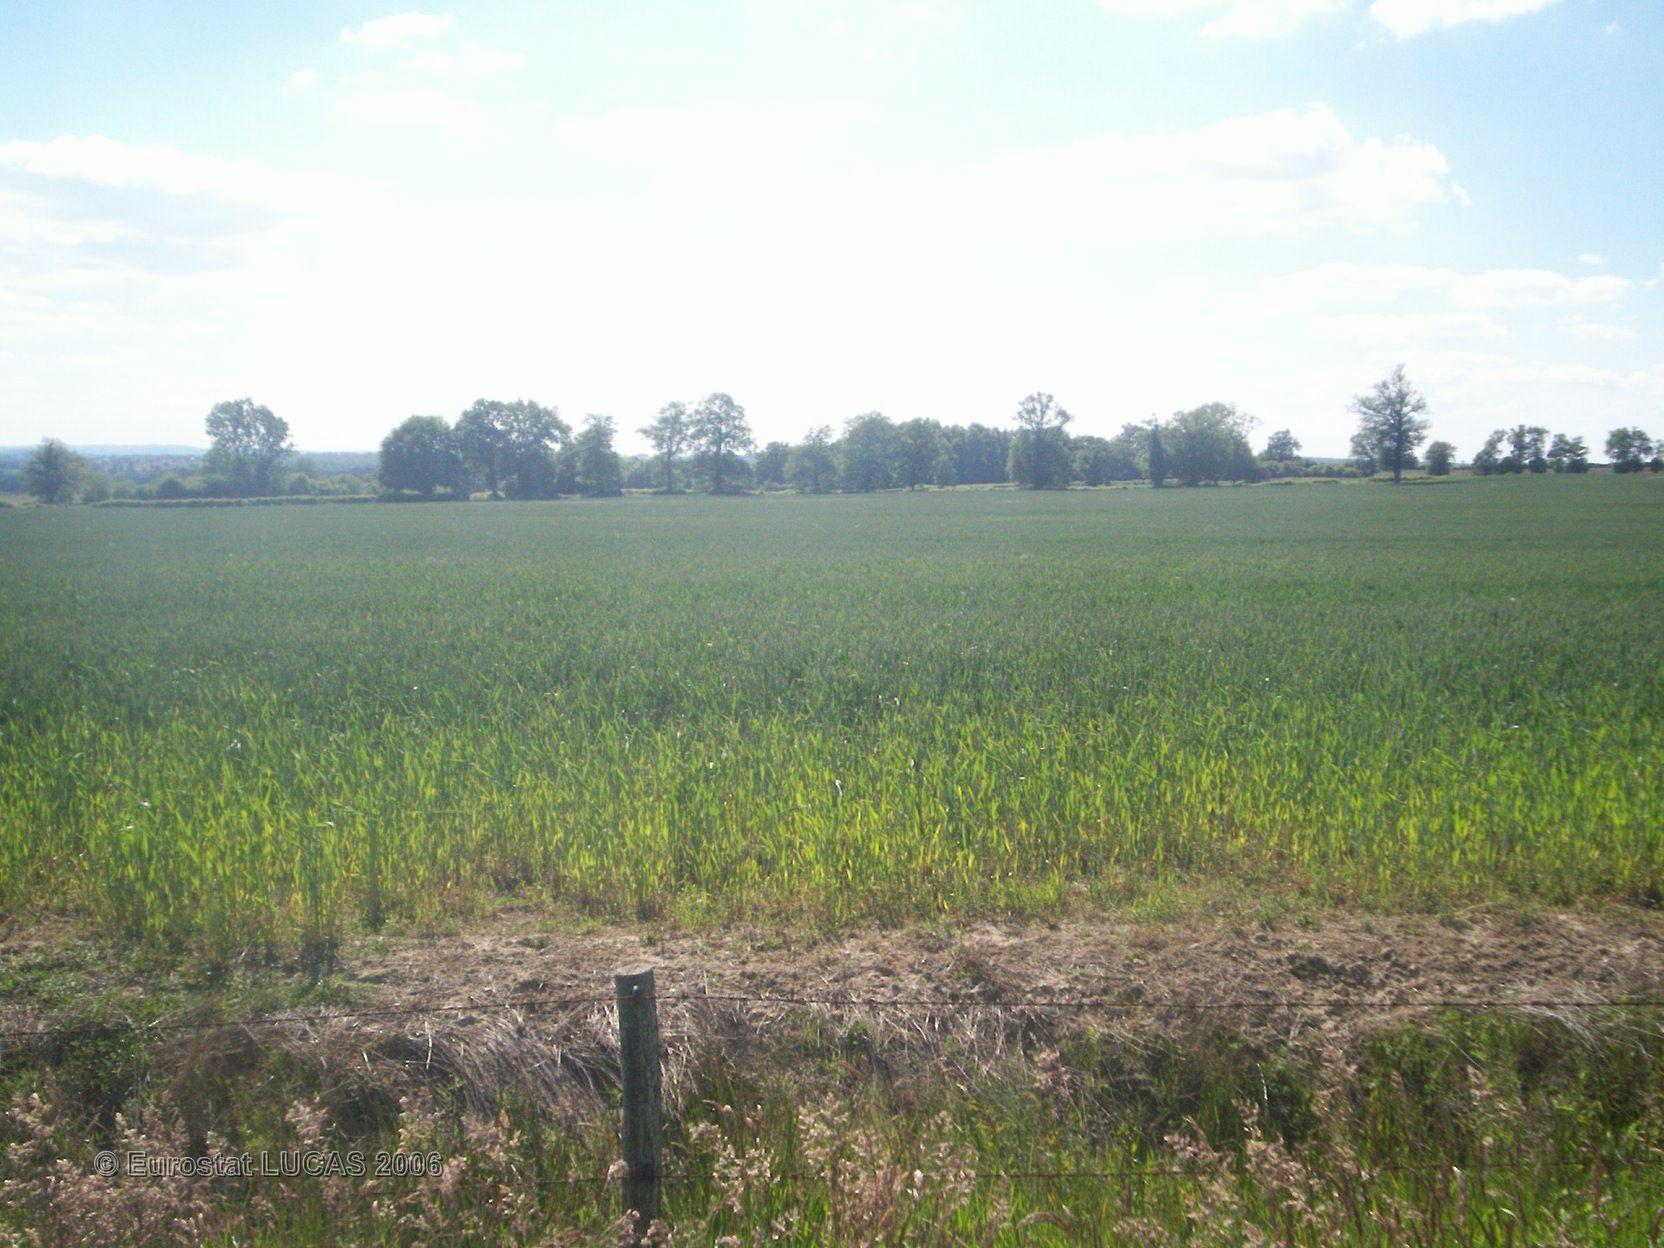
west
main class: Grassland
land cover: Grassland without tree/shrub cover
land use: Agriculture (excluding fallow land and kitchen gardens)
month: June
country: FR
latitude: 46.3109
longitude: 3.1289
